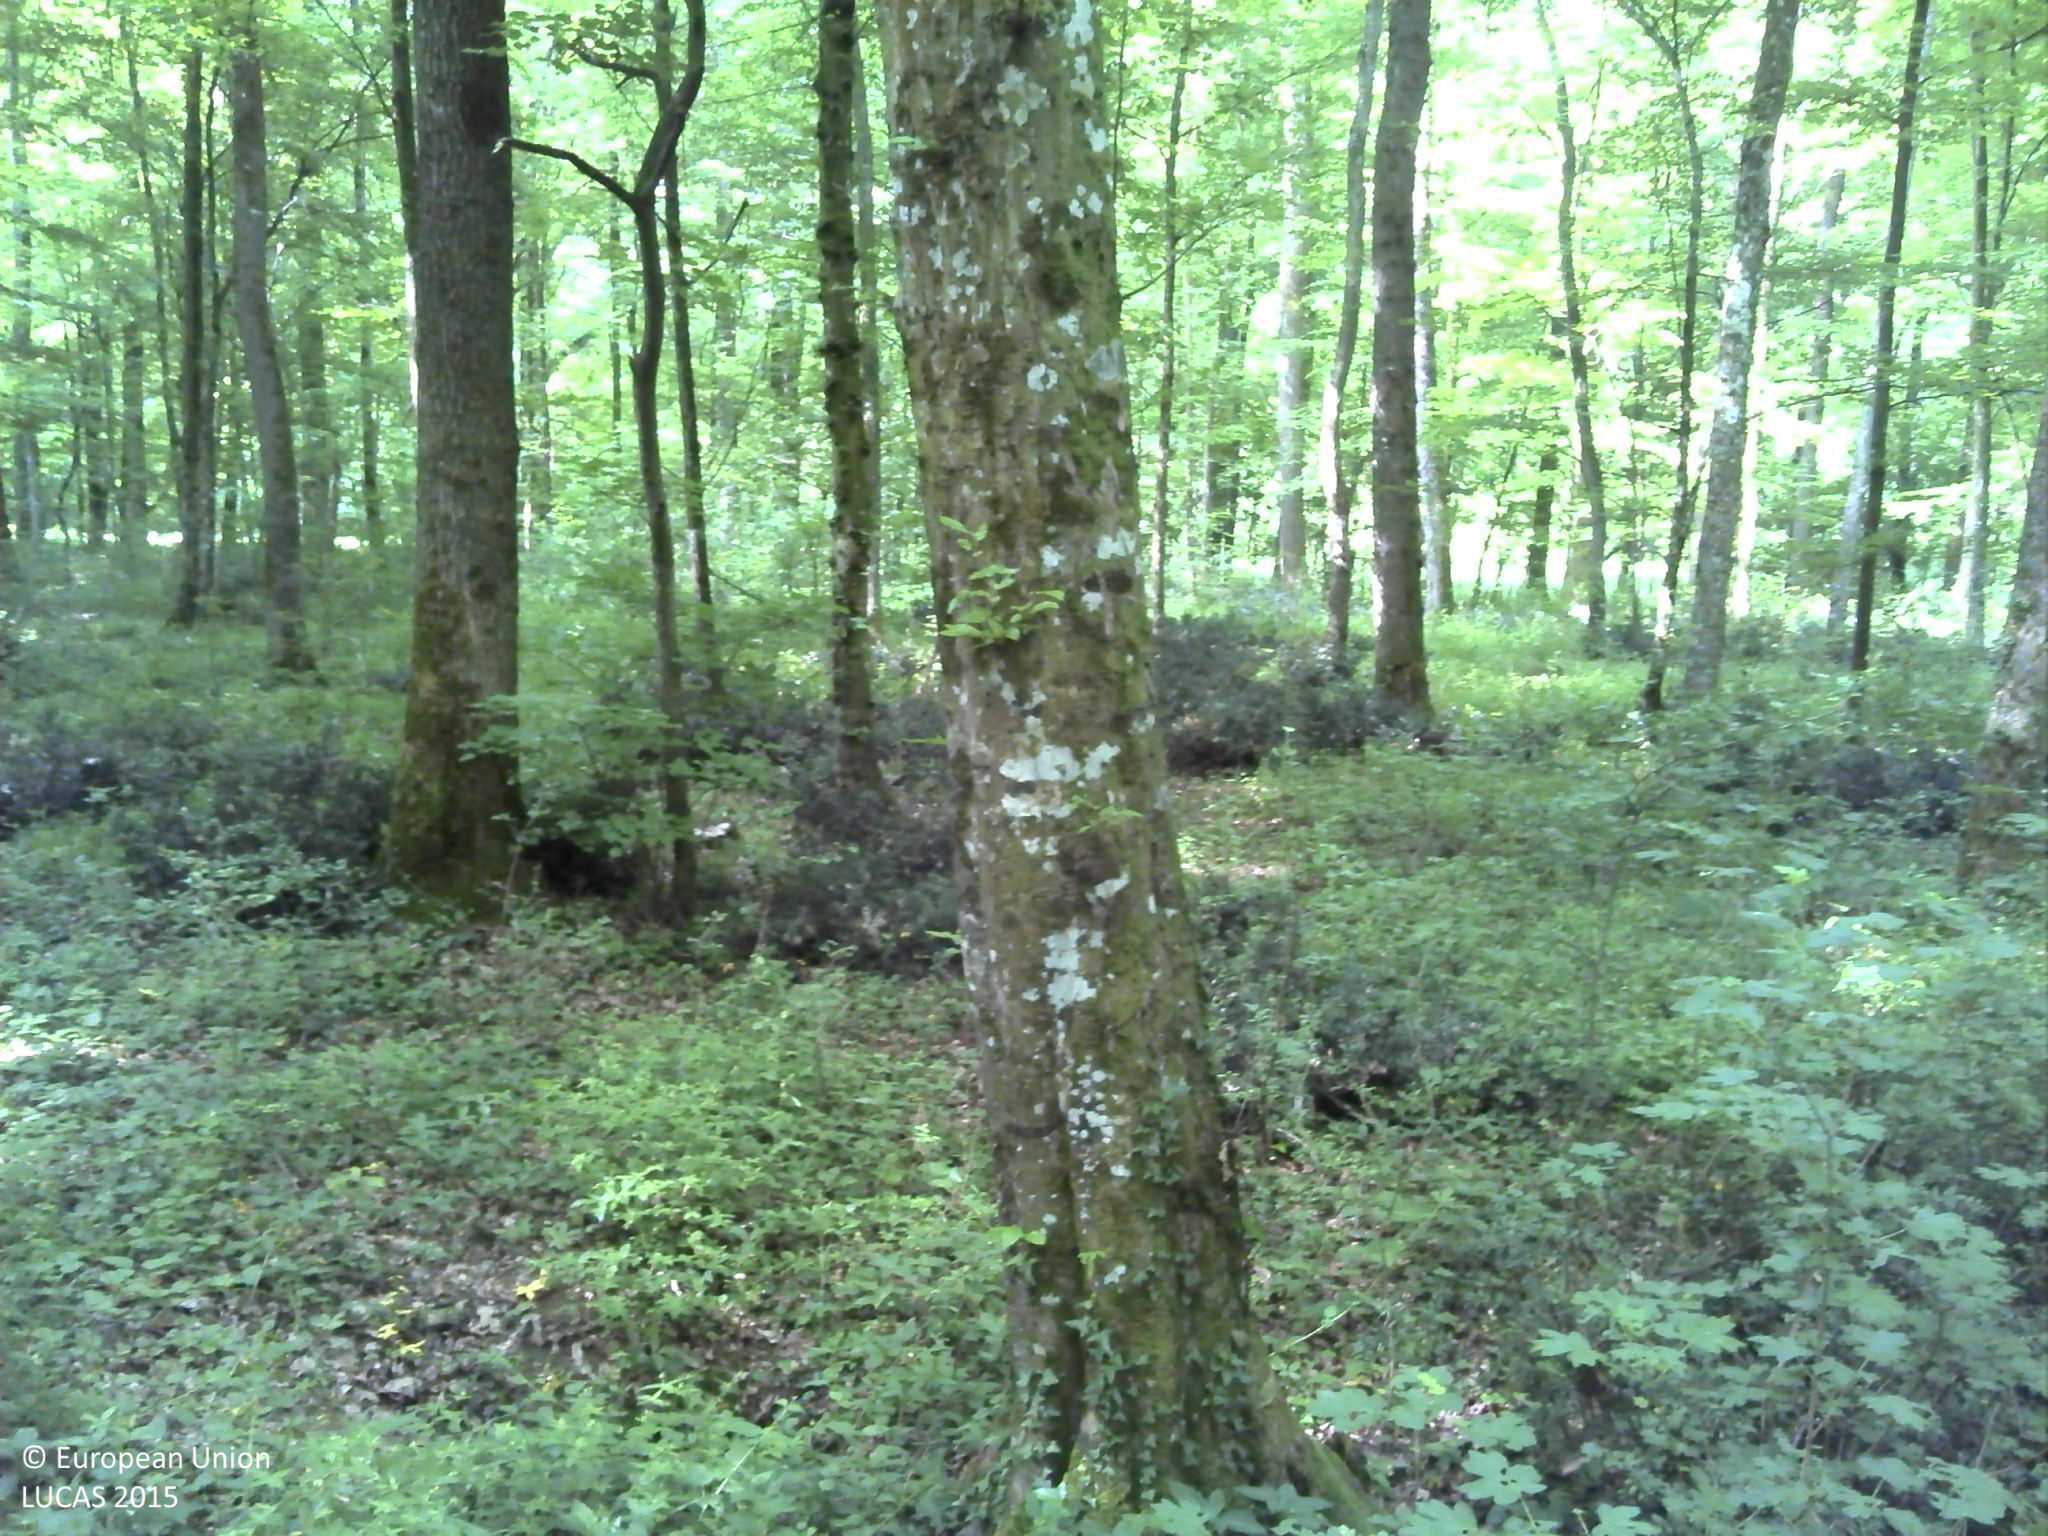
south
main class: Woodland
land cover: Broadleaved woodland
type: acidophilous oak and oak-birch forest
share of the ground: > 75 %
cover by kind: broadleaved forest trees 100 %
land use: Forestry
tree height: > 5 m
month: May
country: HR
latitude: 45.6156
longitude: 18.2512
